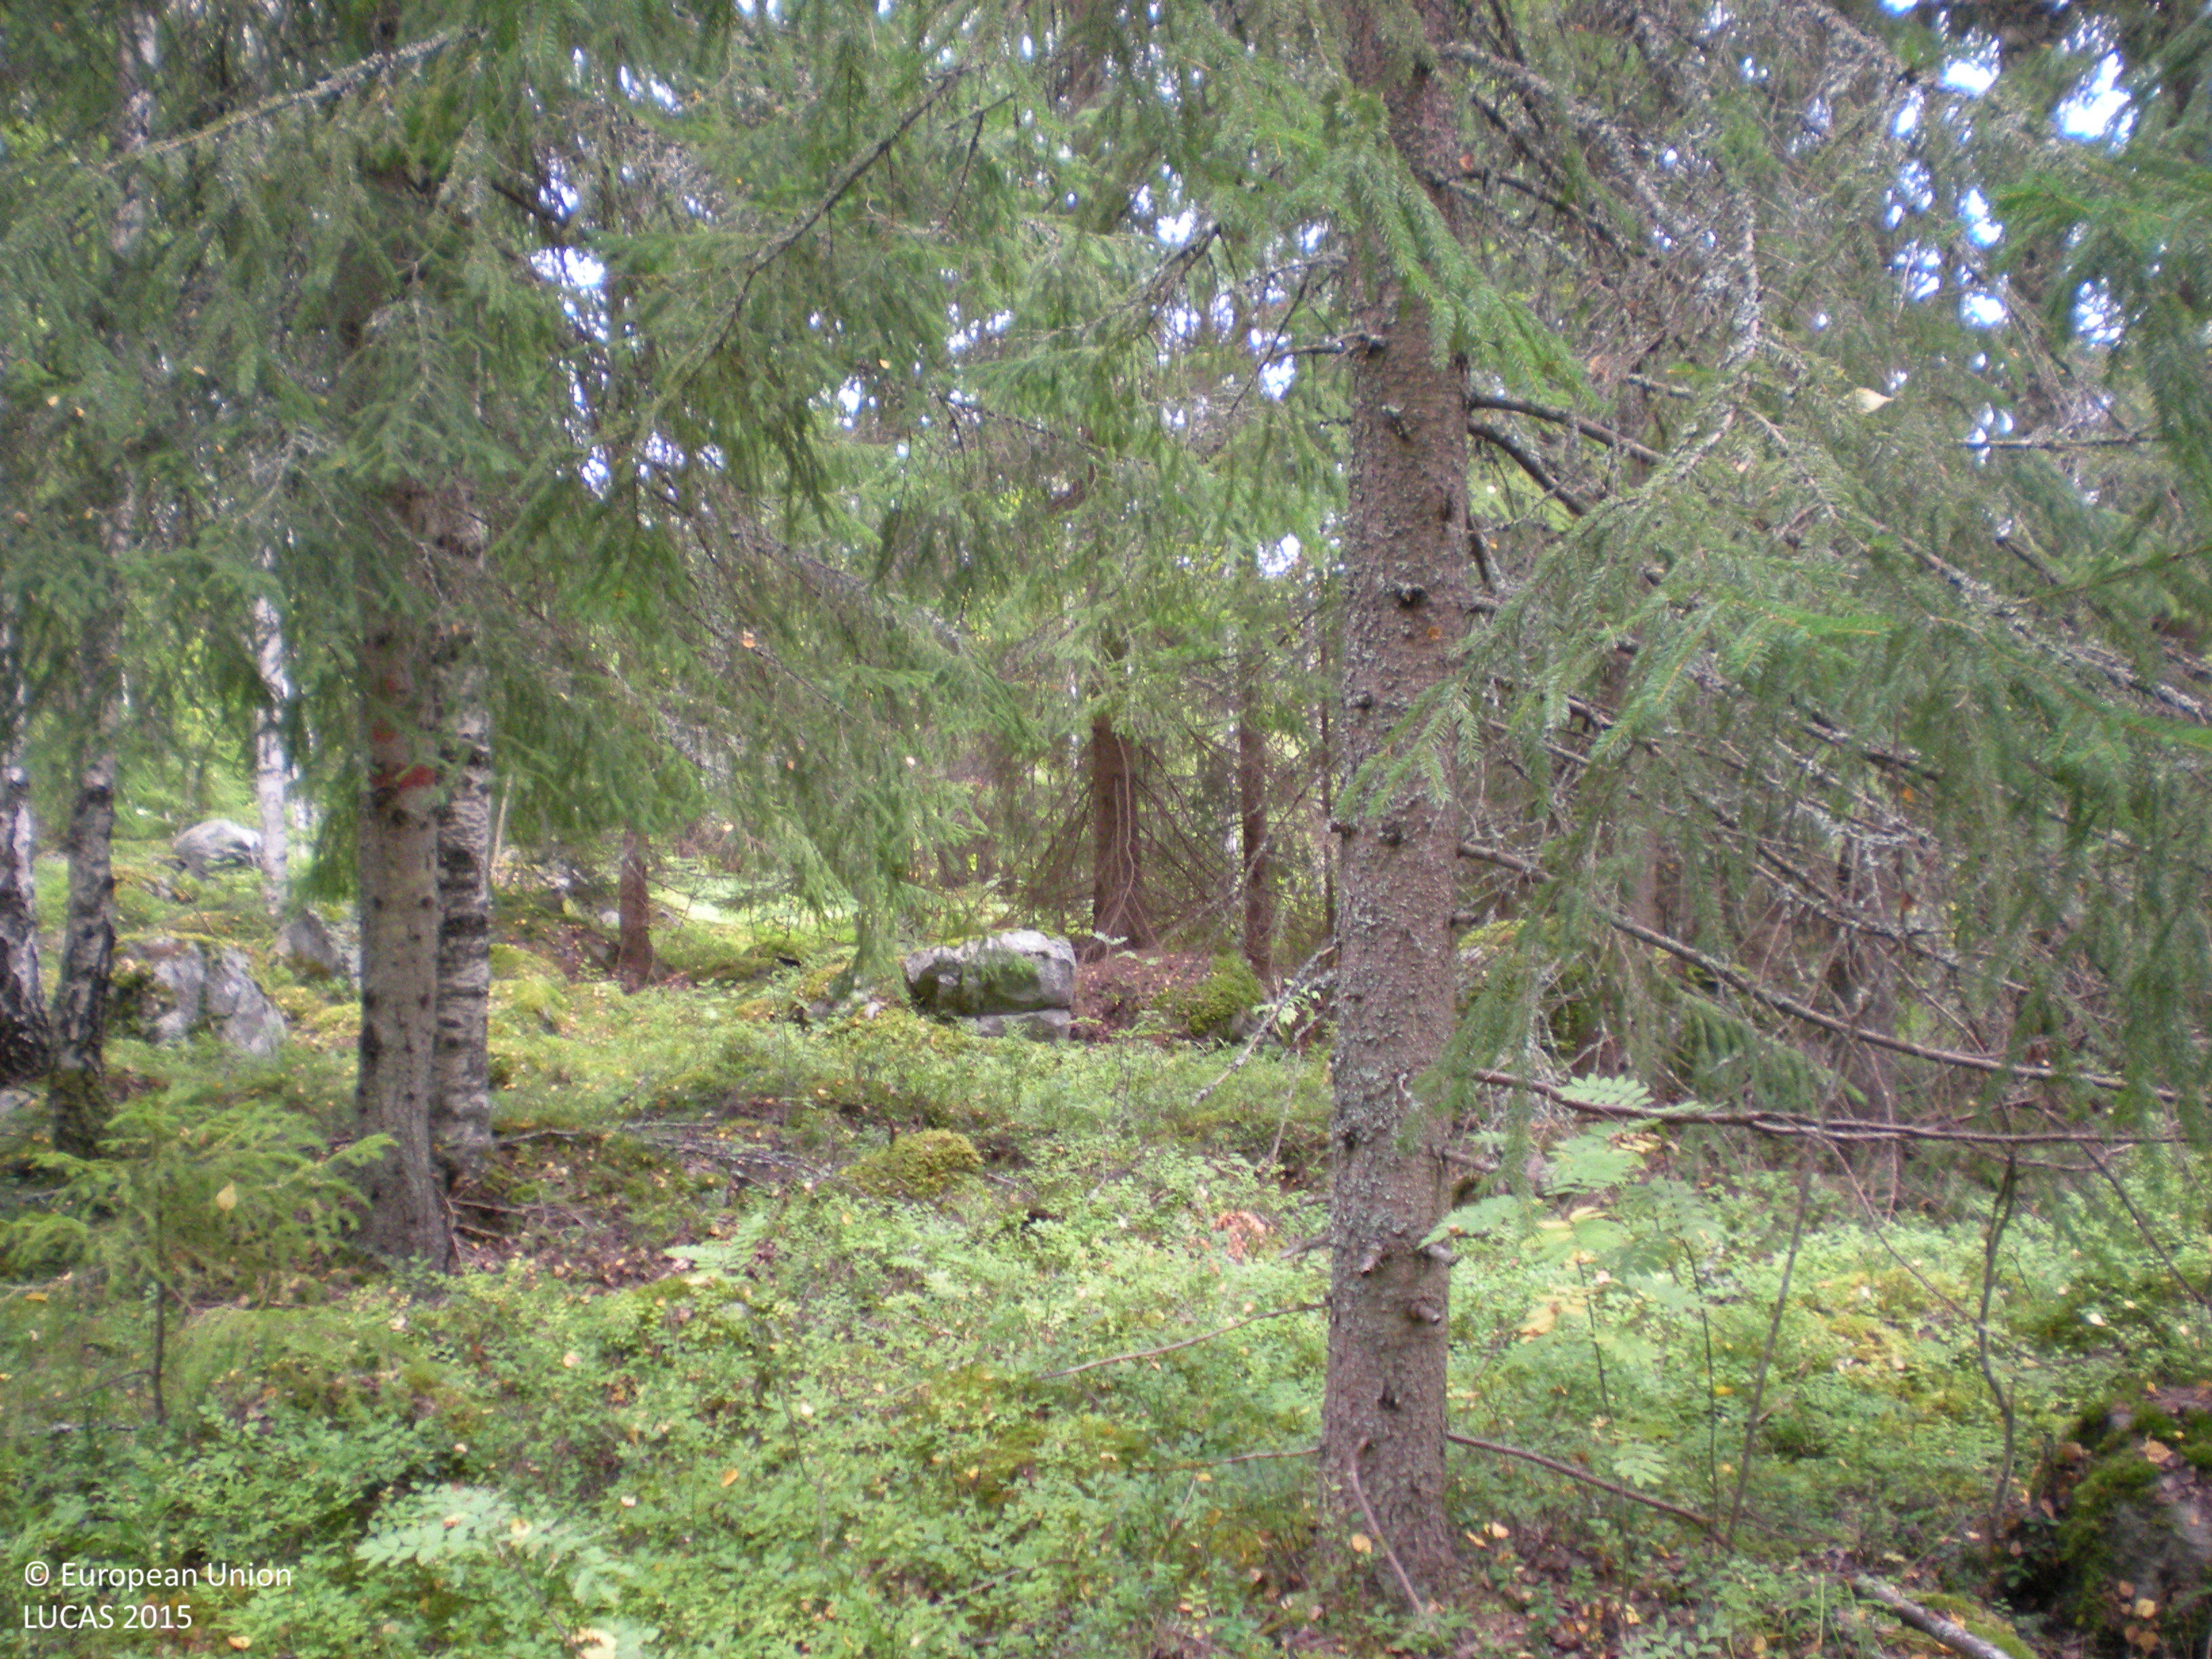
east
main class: Woodland
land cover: Spruce dominated coniferous woodland
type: boreal forest
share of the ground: 50 - 75 %
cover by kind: coniferous forest trees 55 %, shrubs 20 %, broadleaved forest trees 15 %, lichens and mosses 5 %, consolidated bare surface 5 %
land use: Forestry
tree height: > 5 m
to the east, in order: Spruce dominated coniferous woodland; Broadleaved woodland; Spruce dominated mixed woodland; Broadleaved woodland; Ditches and canals; Broadleaved woodland; Spruce dominated coniferous woodland
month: August
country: SE
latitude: 60.5362
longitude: 17.2621
